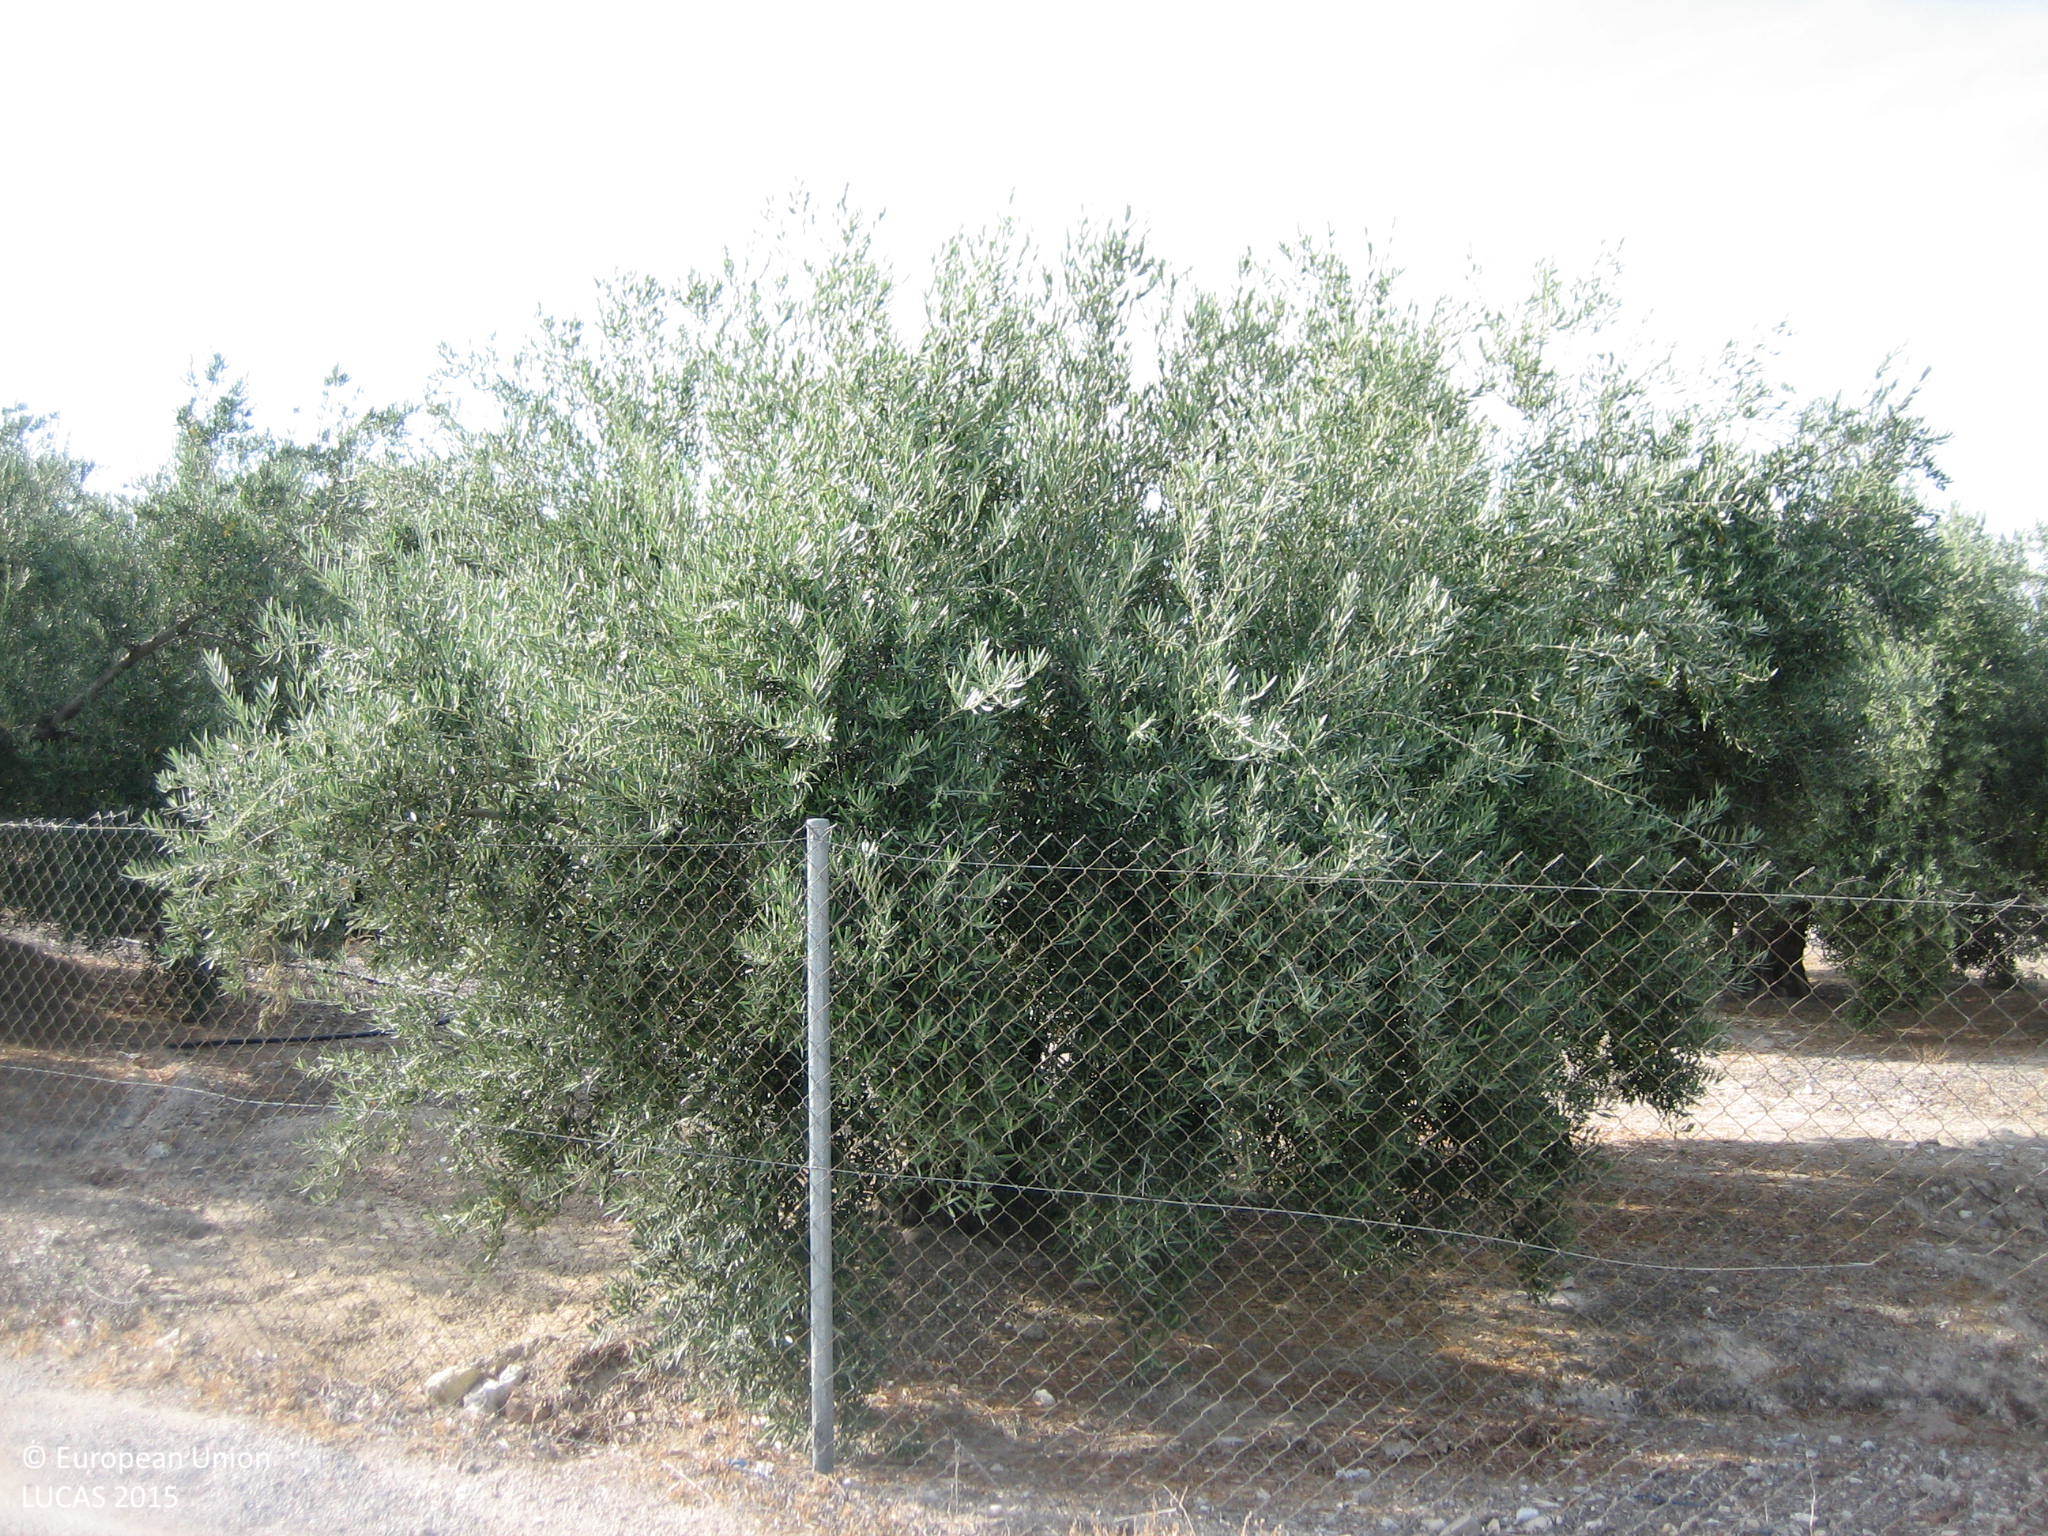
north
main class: Cropland
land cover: Olive groves
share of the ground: 25 - 50 %
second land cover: Other bare soil
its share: > 75 %
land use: Agriculture (excluding fallow land and kitchen gardens)
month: June
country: ES
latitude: 37.7688
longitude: -3.7708
